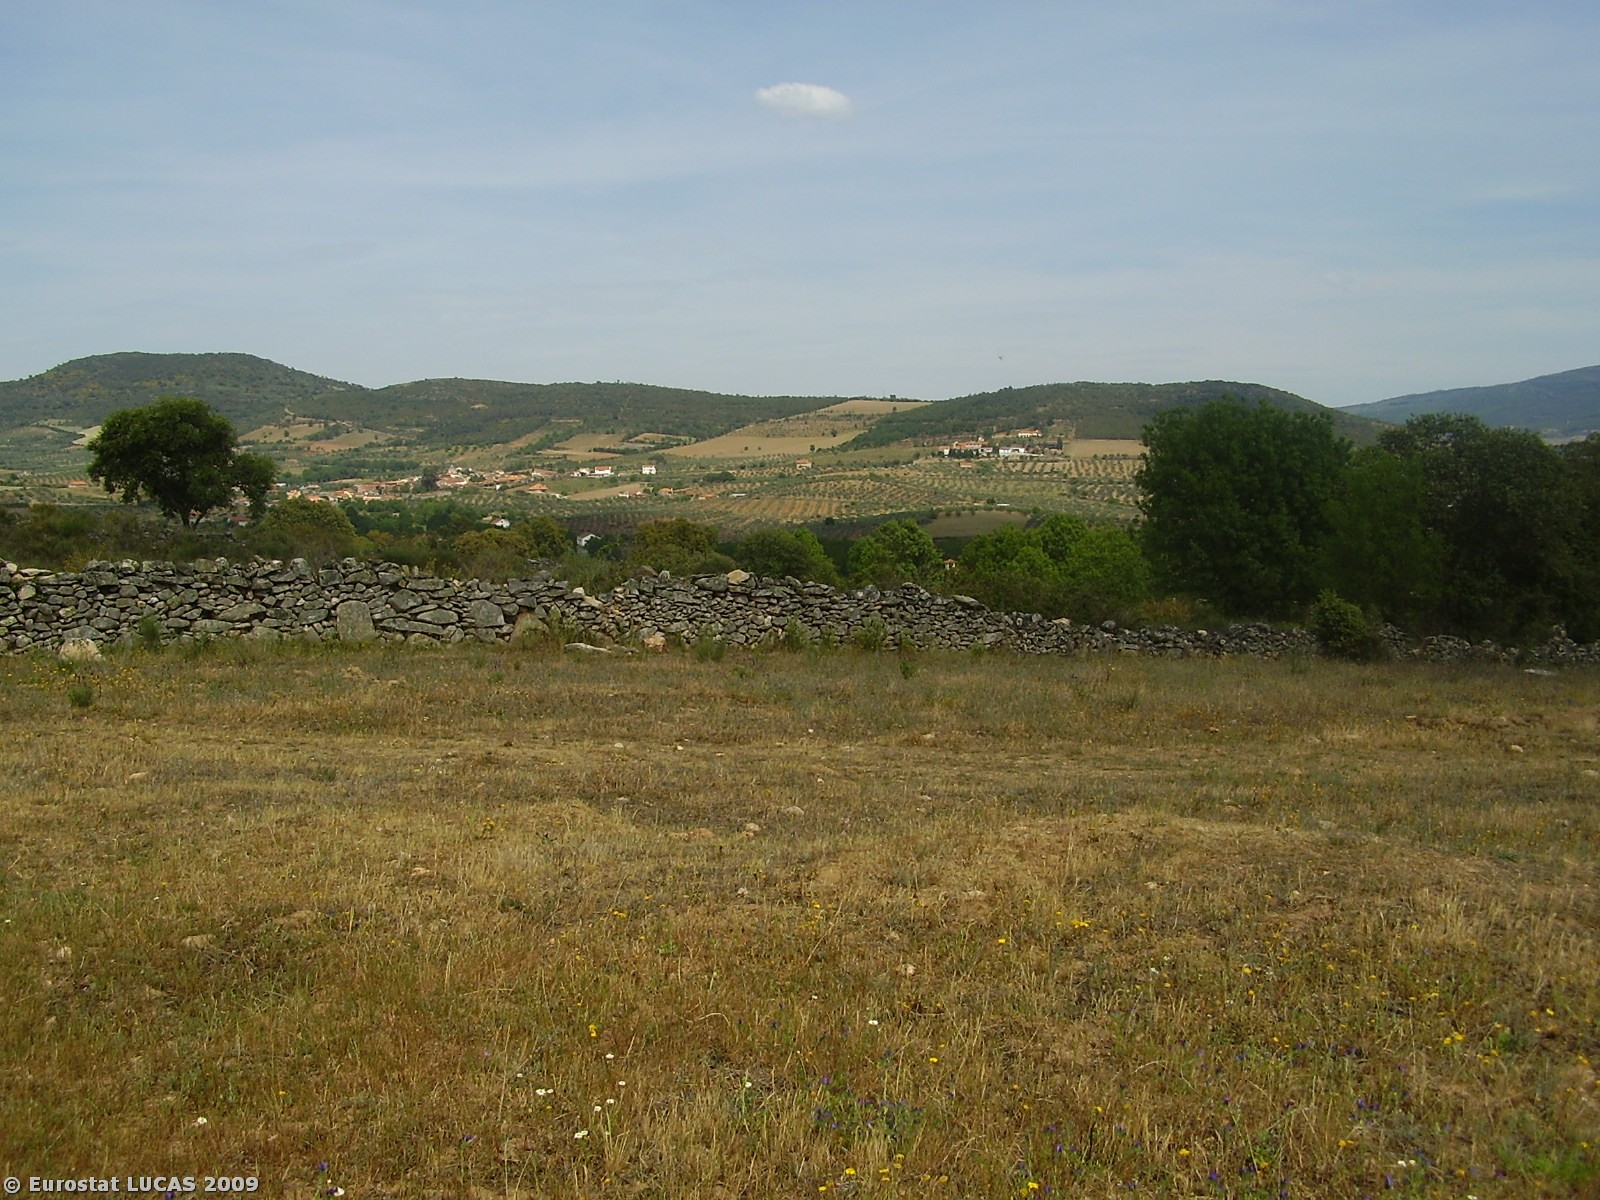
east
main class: Cropland
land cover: Mixed cereals for fodder
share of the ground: 50 - 75 %
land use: Agriculture (excluding fallow land and kitchen gardens)
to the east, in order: Mixed cereals for fodder; Dry stone walls; Spontaneously vegetated surfaces; Shrubland without tree cover; Dry stone walls; Tracks; Grassland without tree/shrub cover; Dry stone walls; Abandoned hedges; Grassland without tree/shrub cover; Abandoned hedges; Dry stone walls; Grass margins; Tracks
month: May
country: PT
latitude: 41.5097
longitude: -7.0453
